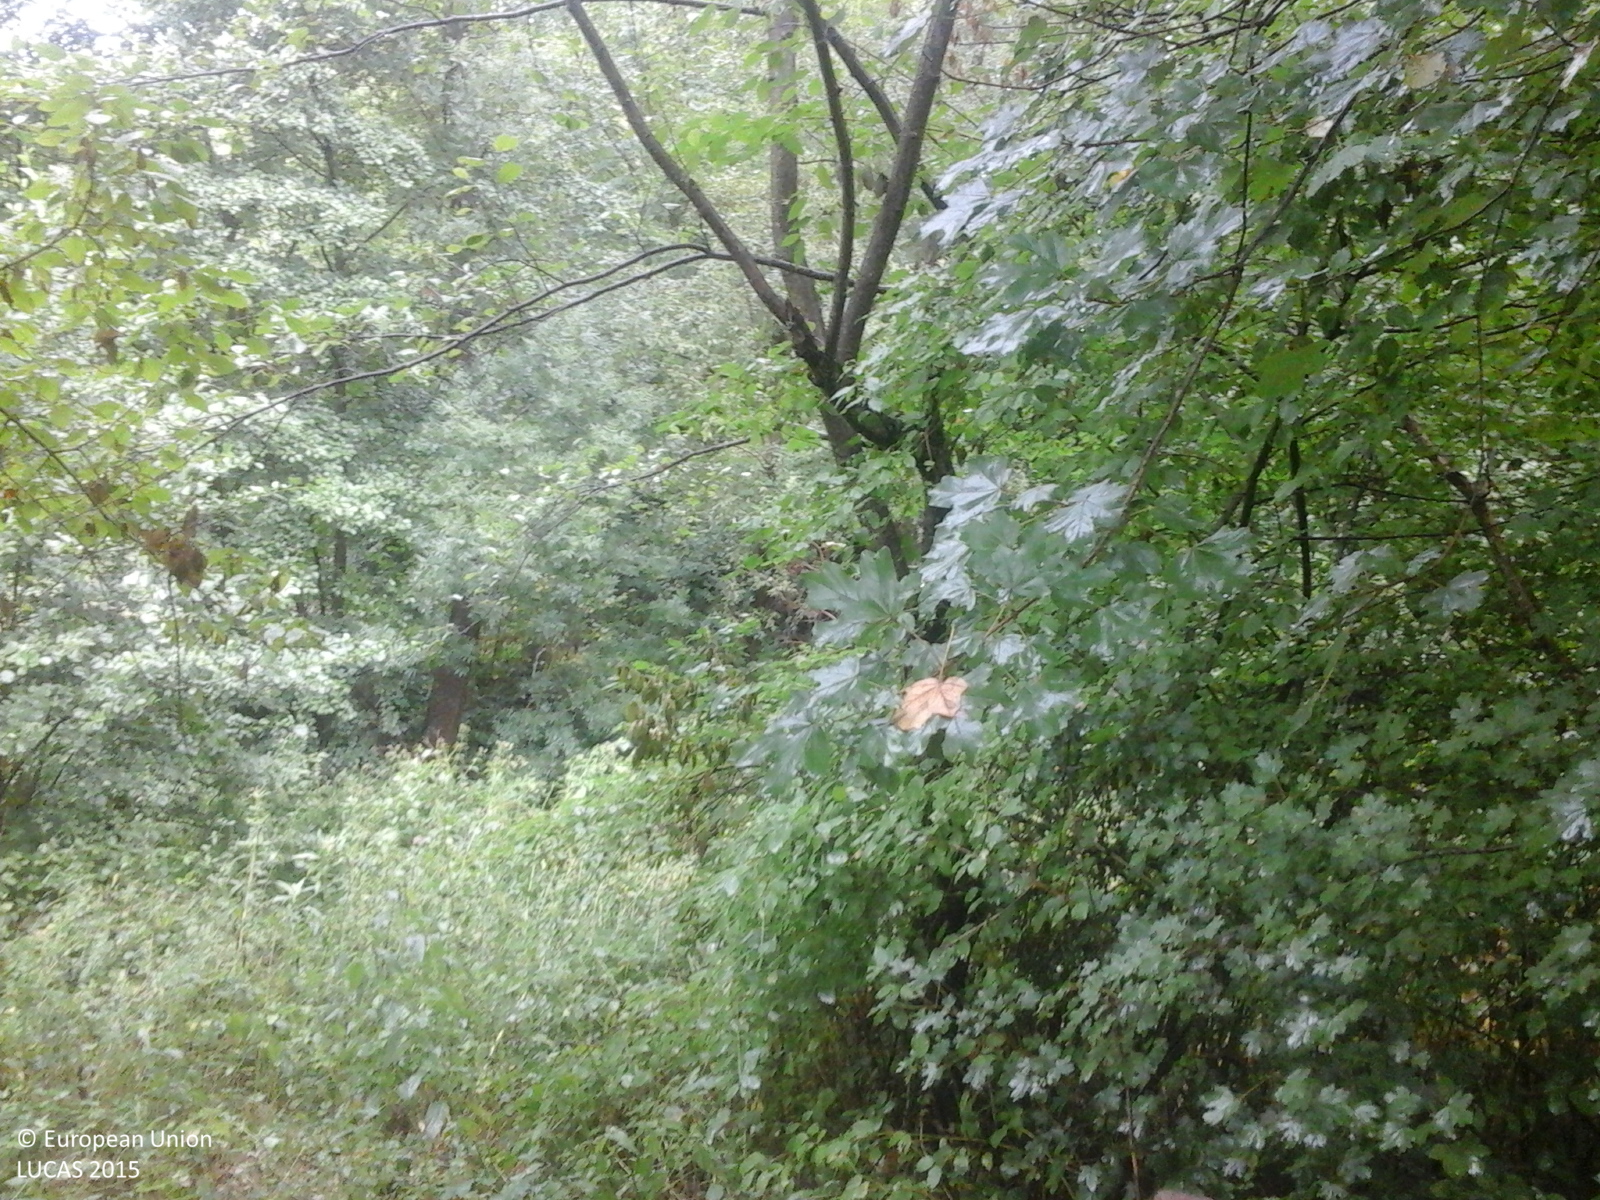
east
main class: Woodland
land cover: Broadleaved woodland
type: mesophytic deciduous forest
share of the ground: > 75 %
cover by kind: broadleaved forest trees 100 %
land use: Forestry
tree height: > 5 m
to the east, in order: Broadleaved woodland; Rivers and streams; Broadleaved woodland; Grassland without tree/shrub cover; Broadleaved woodland
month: August
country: RO
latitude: 44.9288
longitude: 22.1366
